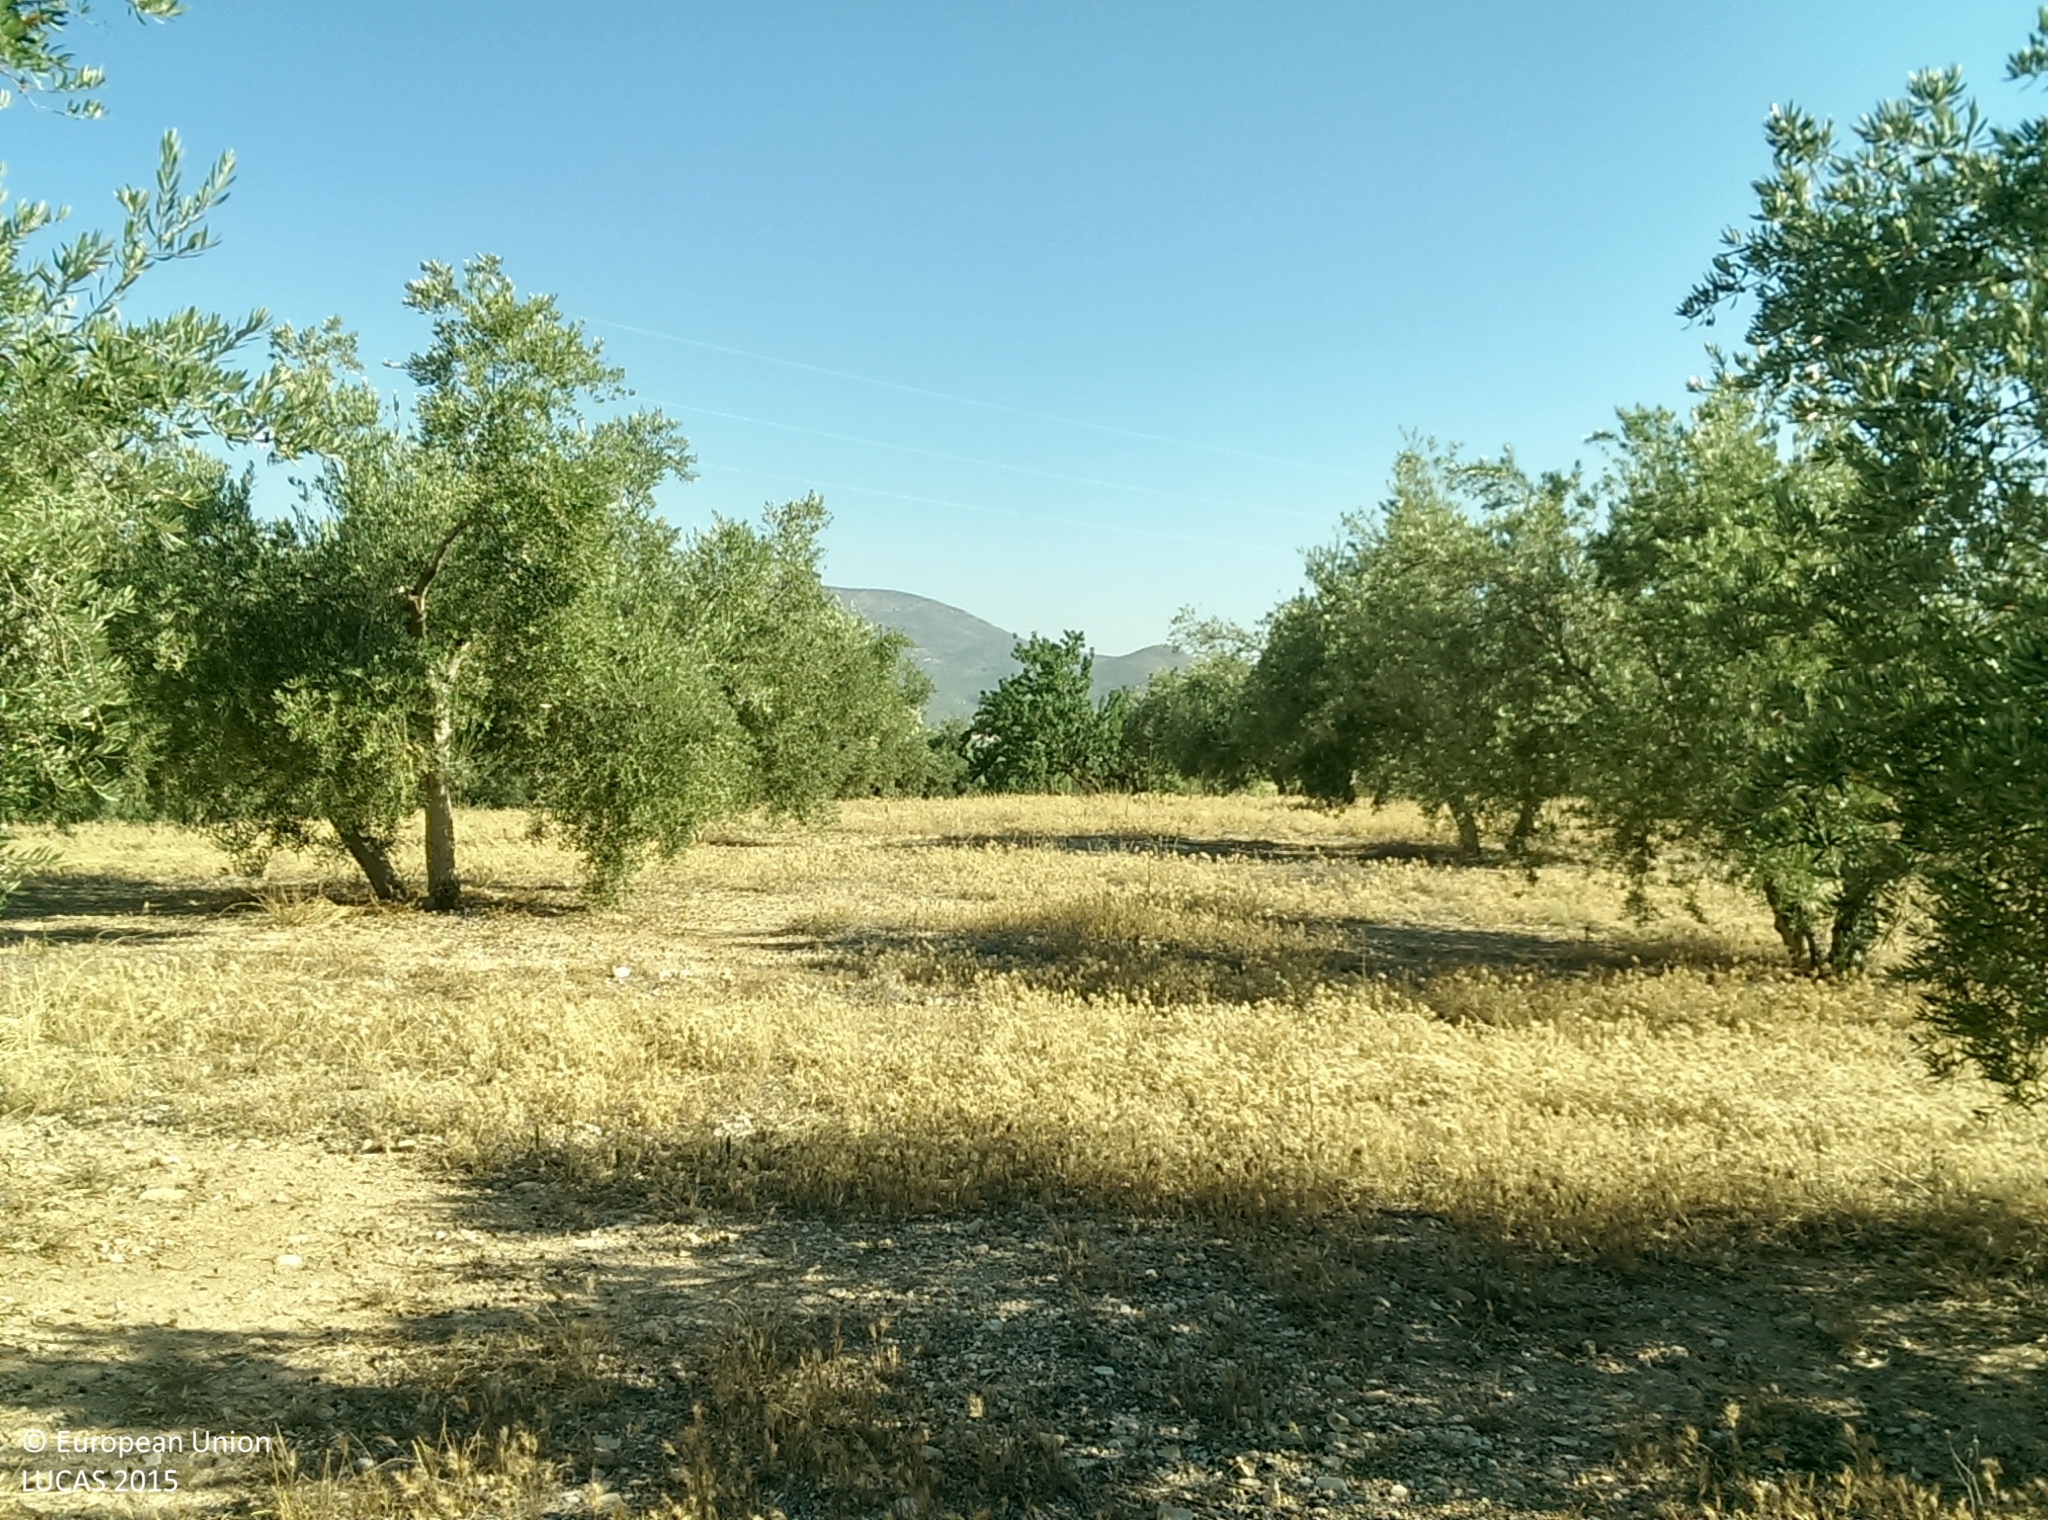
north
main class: Cropland
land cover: Olive groves
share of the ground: 25 - 50 %
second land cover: Spontaneously vegetated surfaces
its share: 25 - 50 %
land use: Agriculture (excluding fallow land and kitchen gardens)
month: July
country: ES
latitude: 37.2987
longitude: -3.7217
